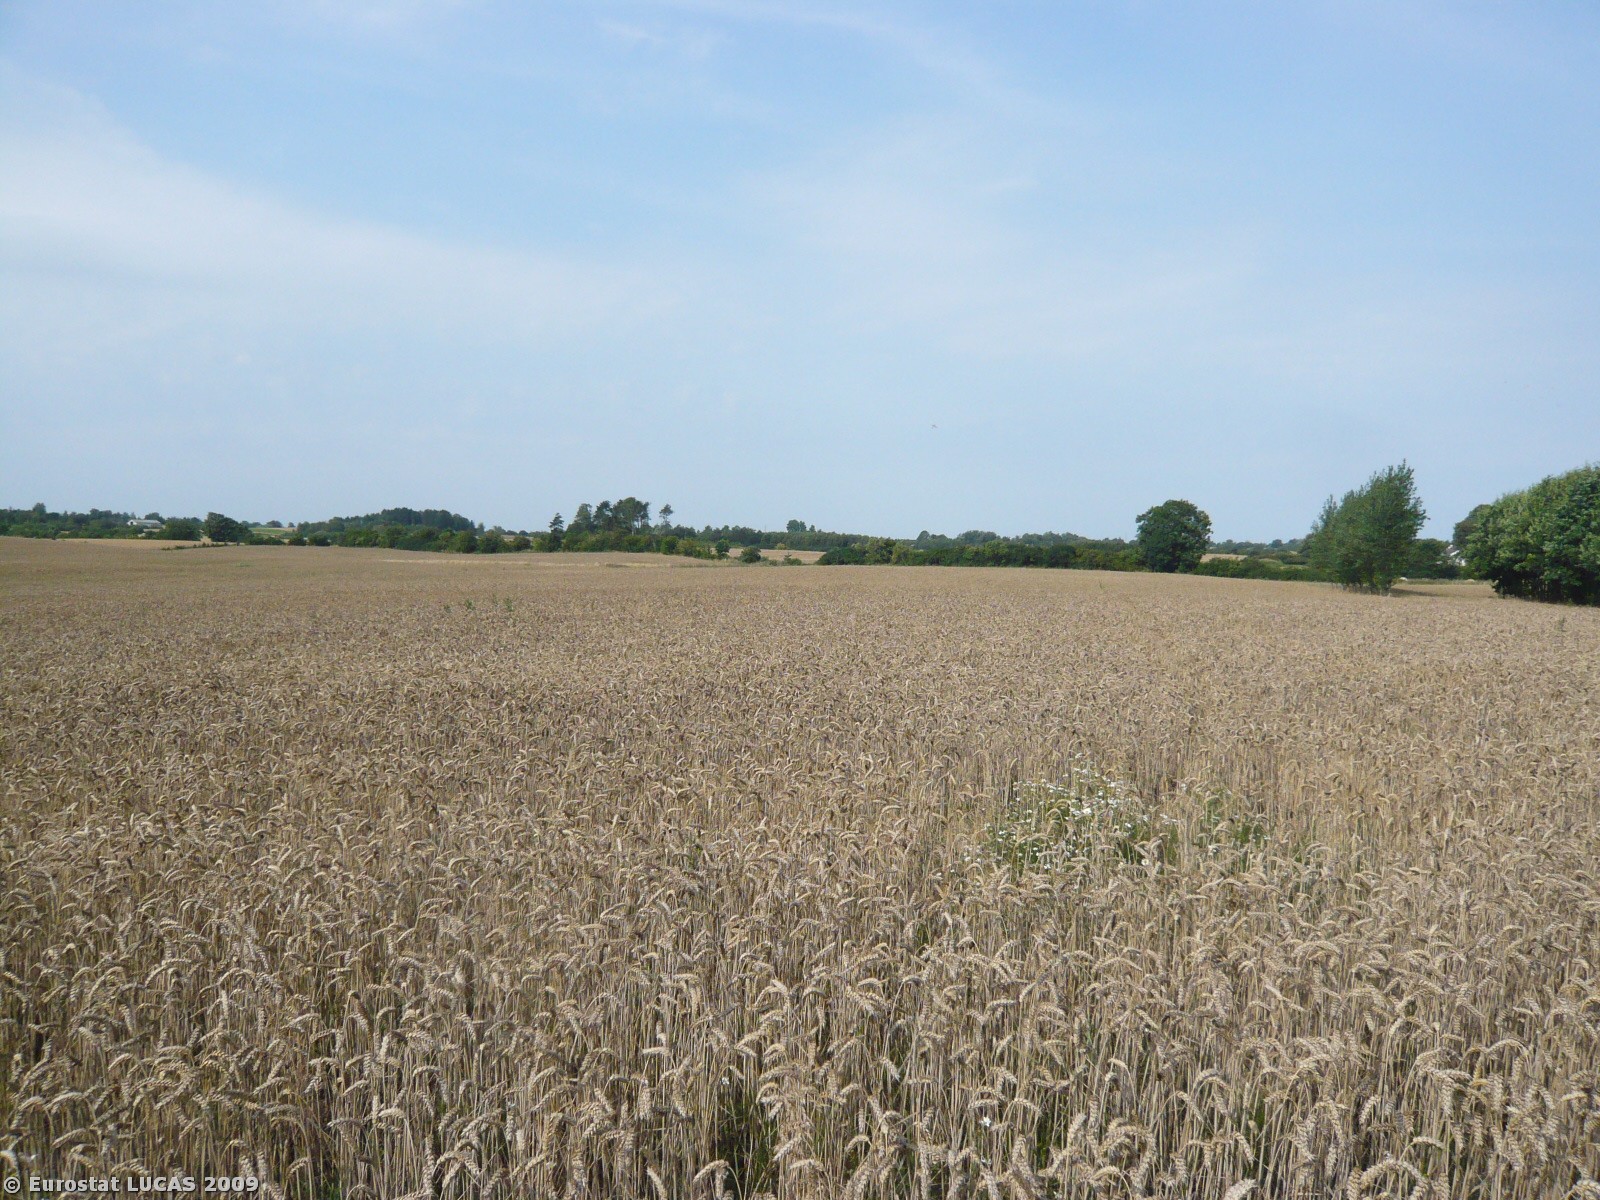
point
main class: Cropland
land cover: Common wheat
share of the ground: > 75 %
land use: Agriculture (excluding fallow land and kitchen gardens)
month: August
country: DK
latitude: 56.0072
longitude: 12.1951
